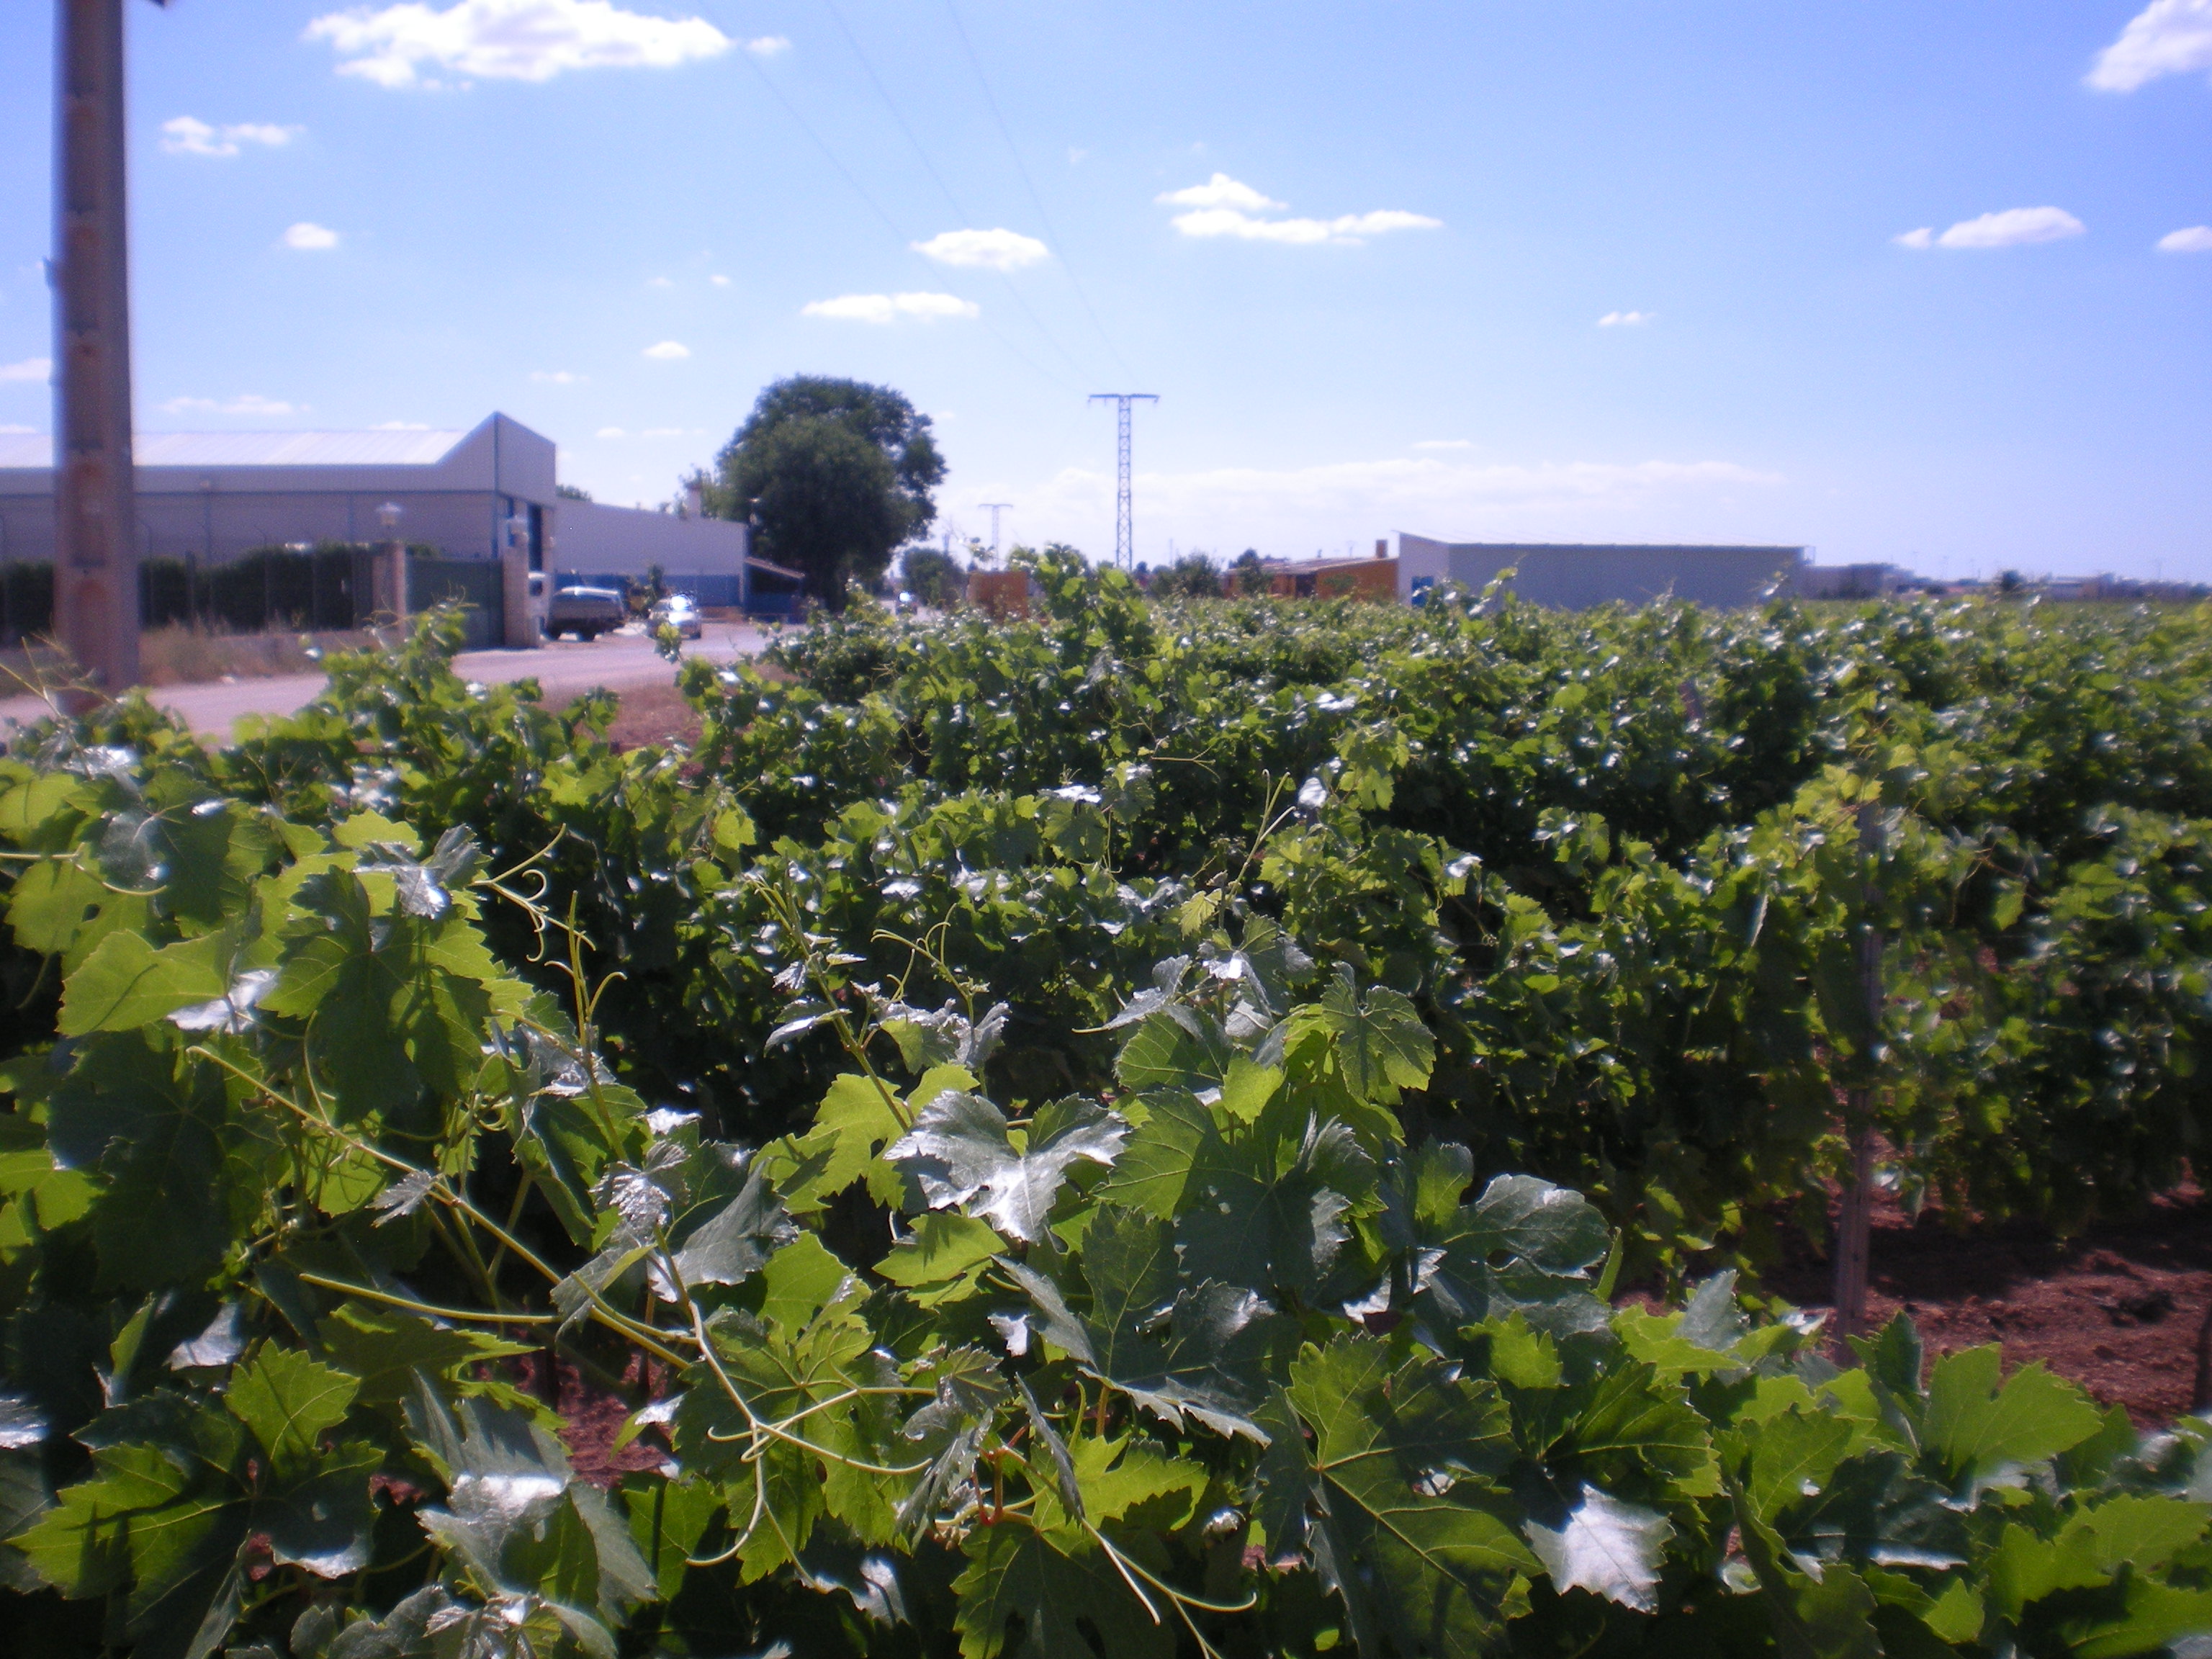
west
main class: Cropland
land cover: Vineyards
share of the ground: 10 - 25 %
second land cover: Other bare soil
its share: > 75 %
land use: Agriculture (excluding fallow land and kitchen gardens)
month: June
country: ES
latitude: 39.1623
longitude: -2.9859
